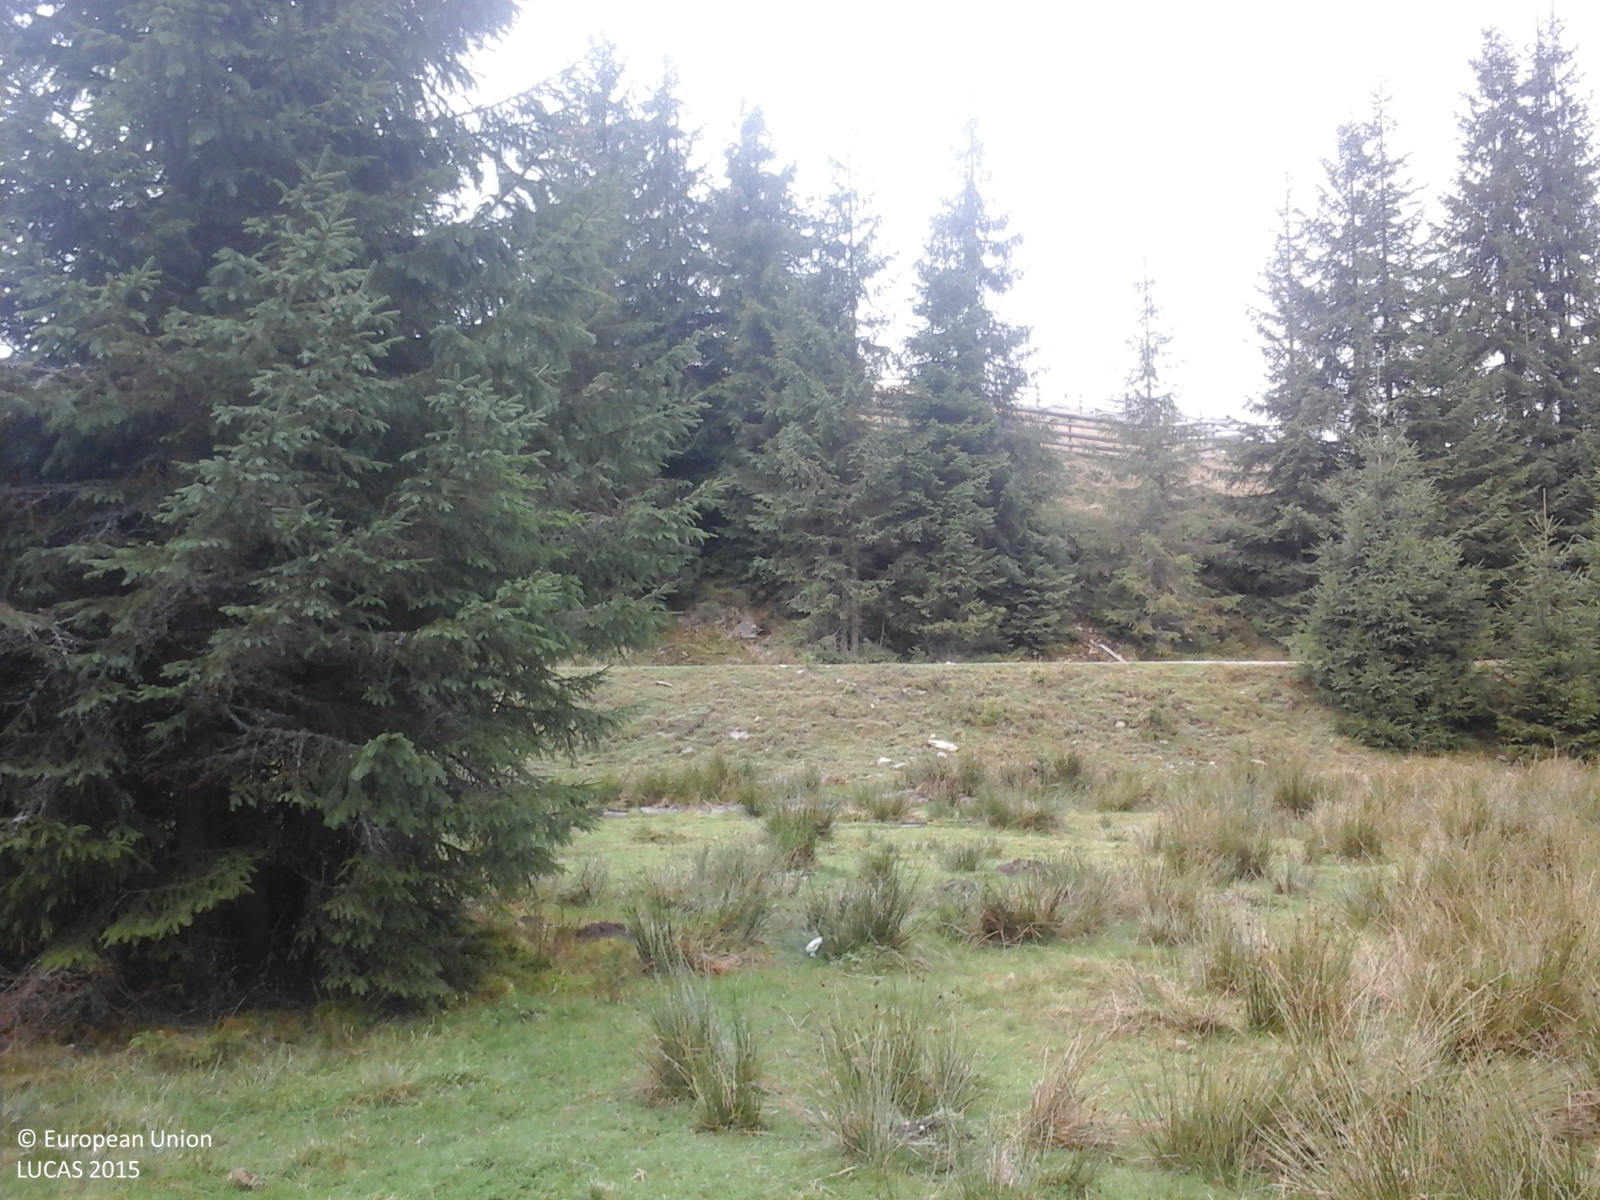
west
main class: Woodland
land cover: Spruce dominated coniferous woodland
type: alpine coniferous forest
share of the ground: > 75 %
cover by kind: coniferous forest trees 100 %
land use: Forestry
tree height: > 5 m
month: September
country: RO
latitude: 46.5698
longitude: 23.0421
